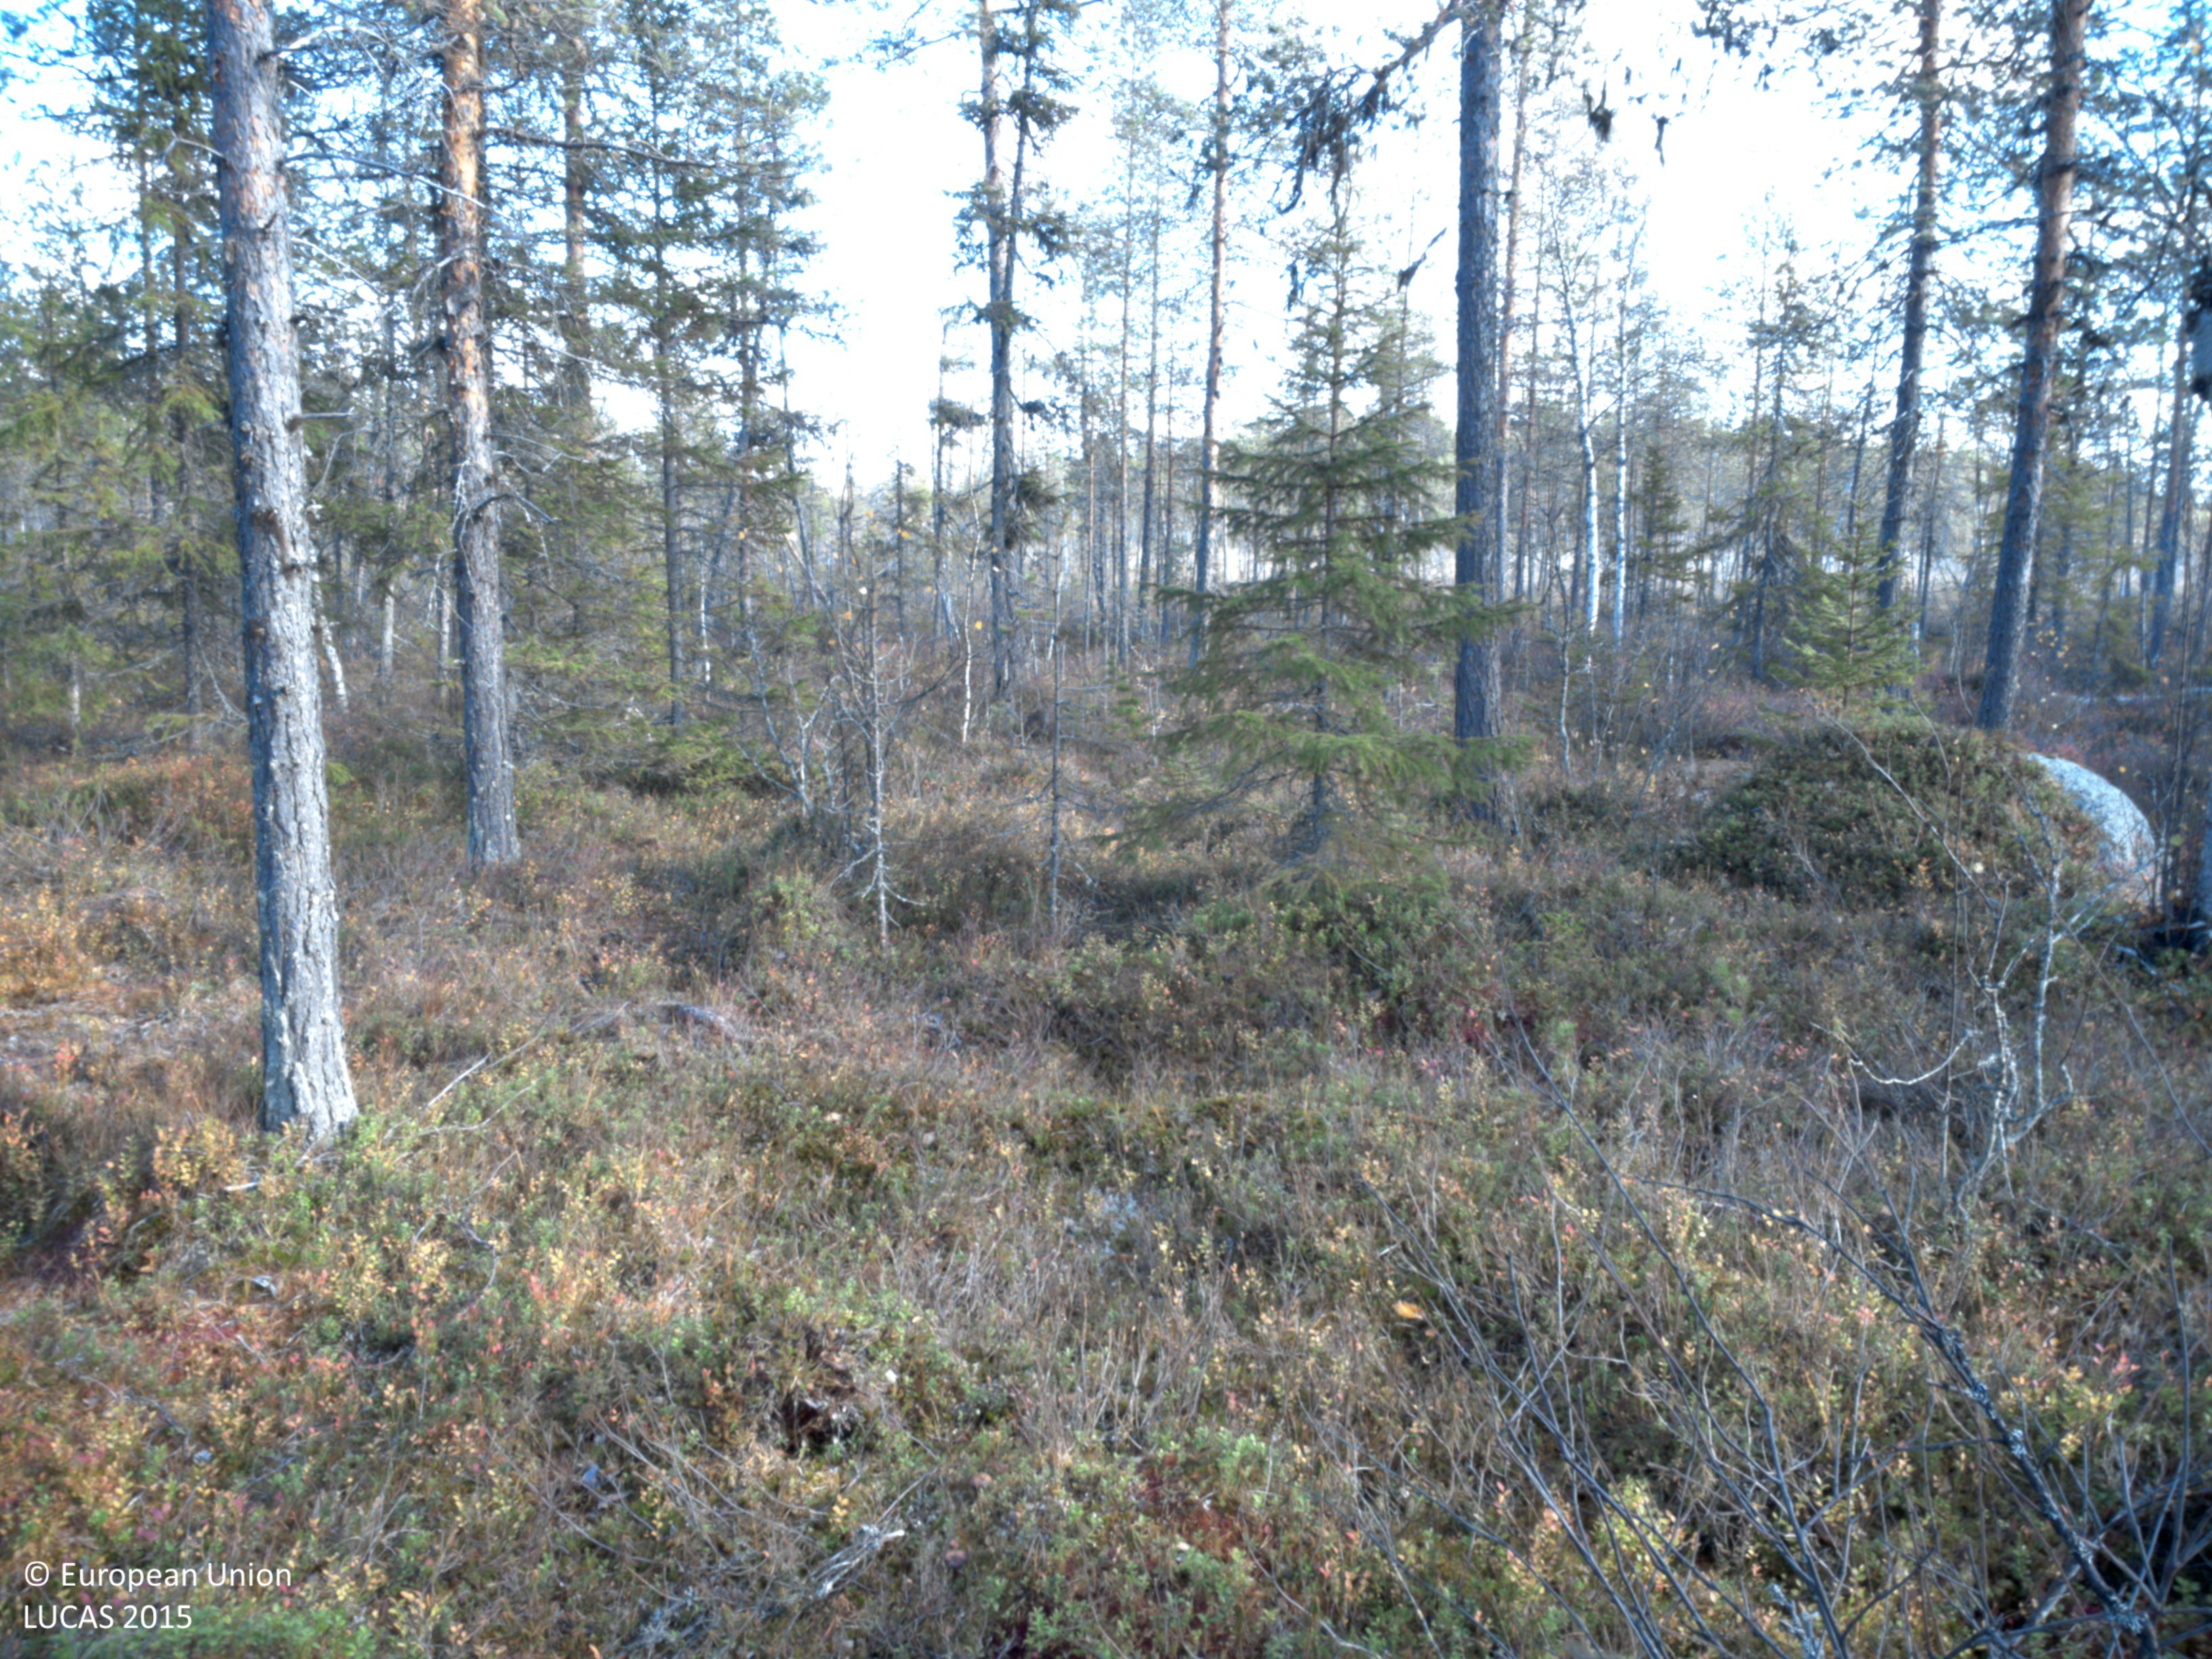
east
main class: Woodland
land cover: Pine dominated coniferous woodland
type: mire and swamp forests
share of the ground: 50 - 75 %
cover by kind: coniferous forest trees 75 %, shrubs 15 %, lichens and mosses 10 %
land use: Forestry
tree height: > 5 m
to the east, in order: Pine dominated coniferous woodland; Peatbogs; Pine dominated coniferous woodland
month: October
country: SE
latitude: 64.8957
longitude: 18.1821
